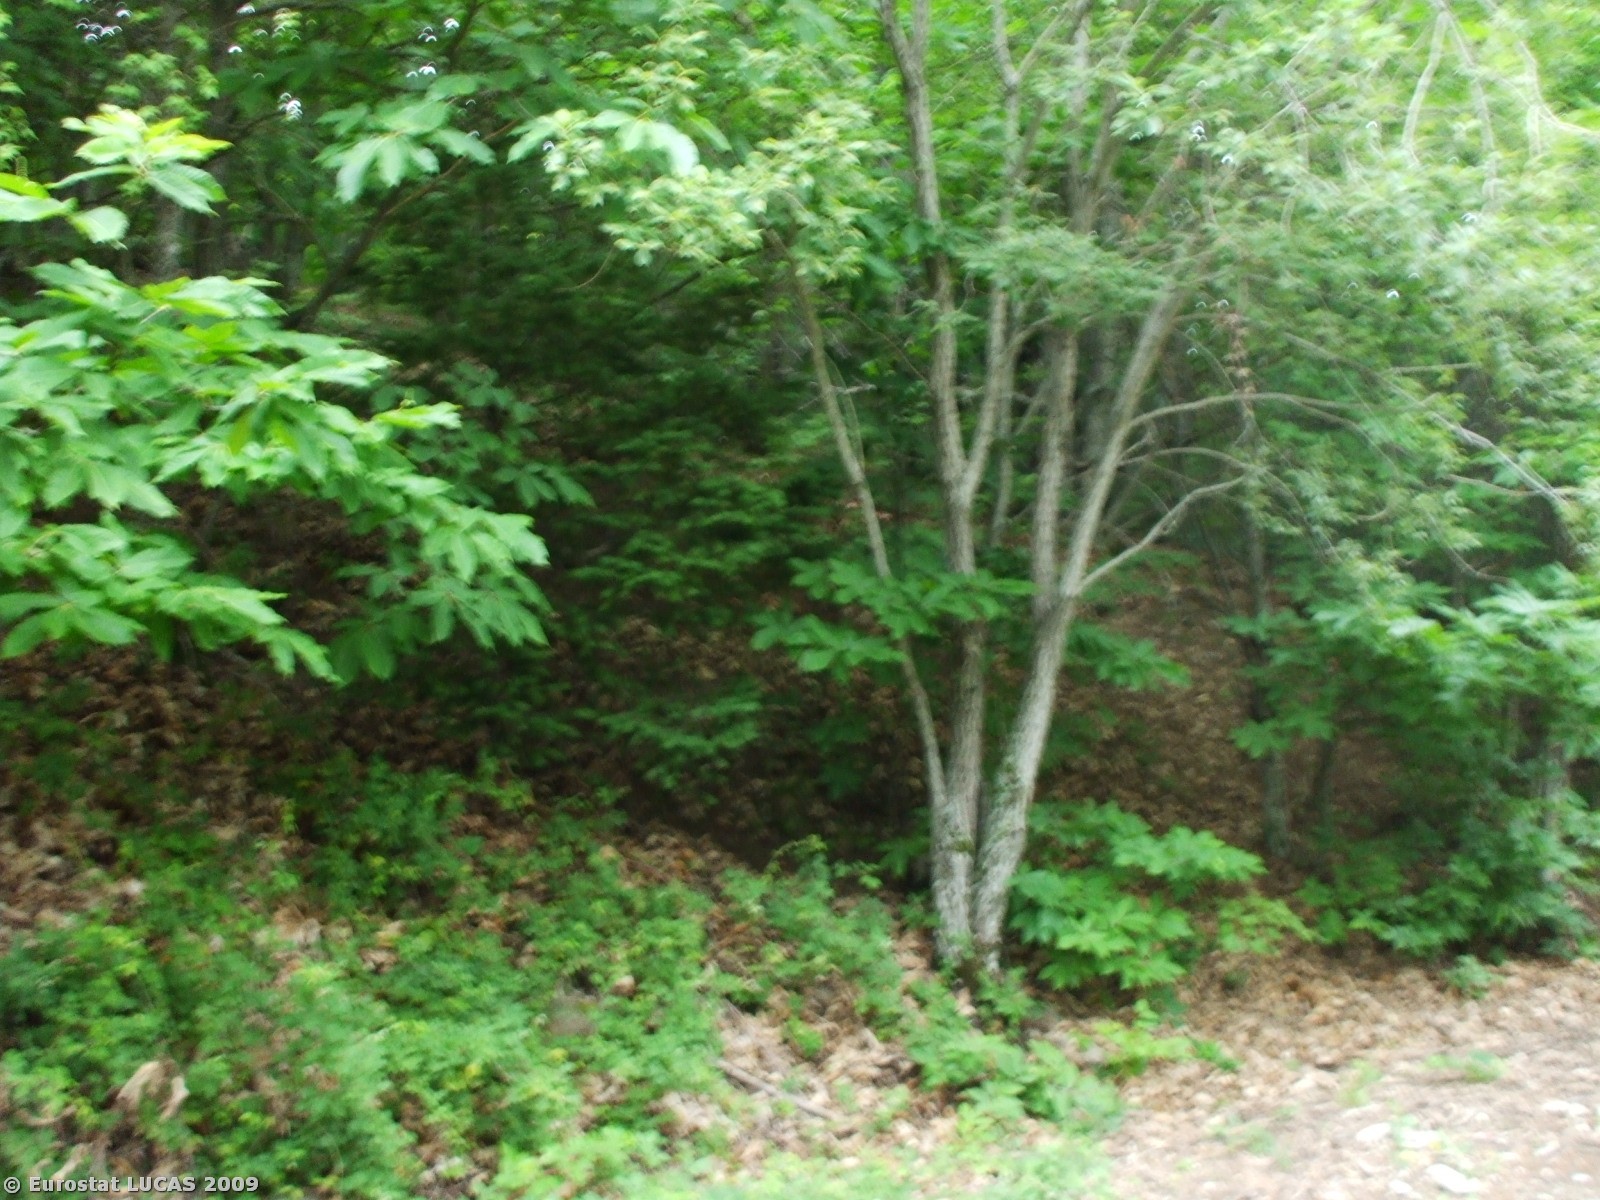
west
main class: Woodland
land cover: Broadleaved woodland
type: thermophilous deciduous forest
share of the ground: > 75 %
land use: Forestry
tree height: > 5 m
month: June
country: IT
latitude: 43.6691
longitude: 11.6946
